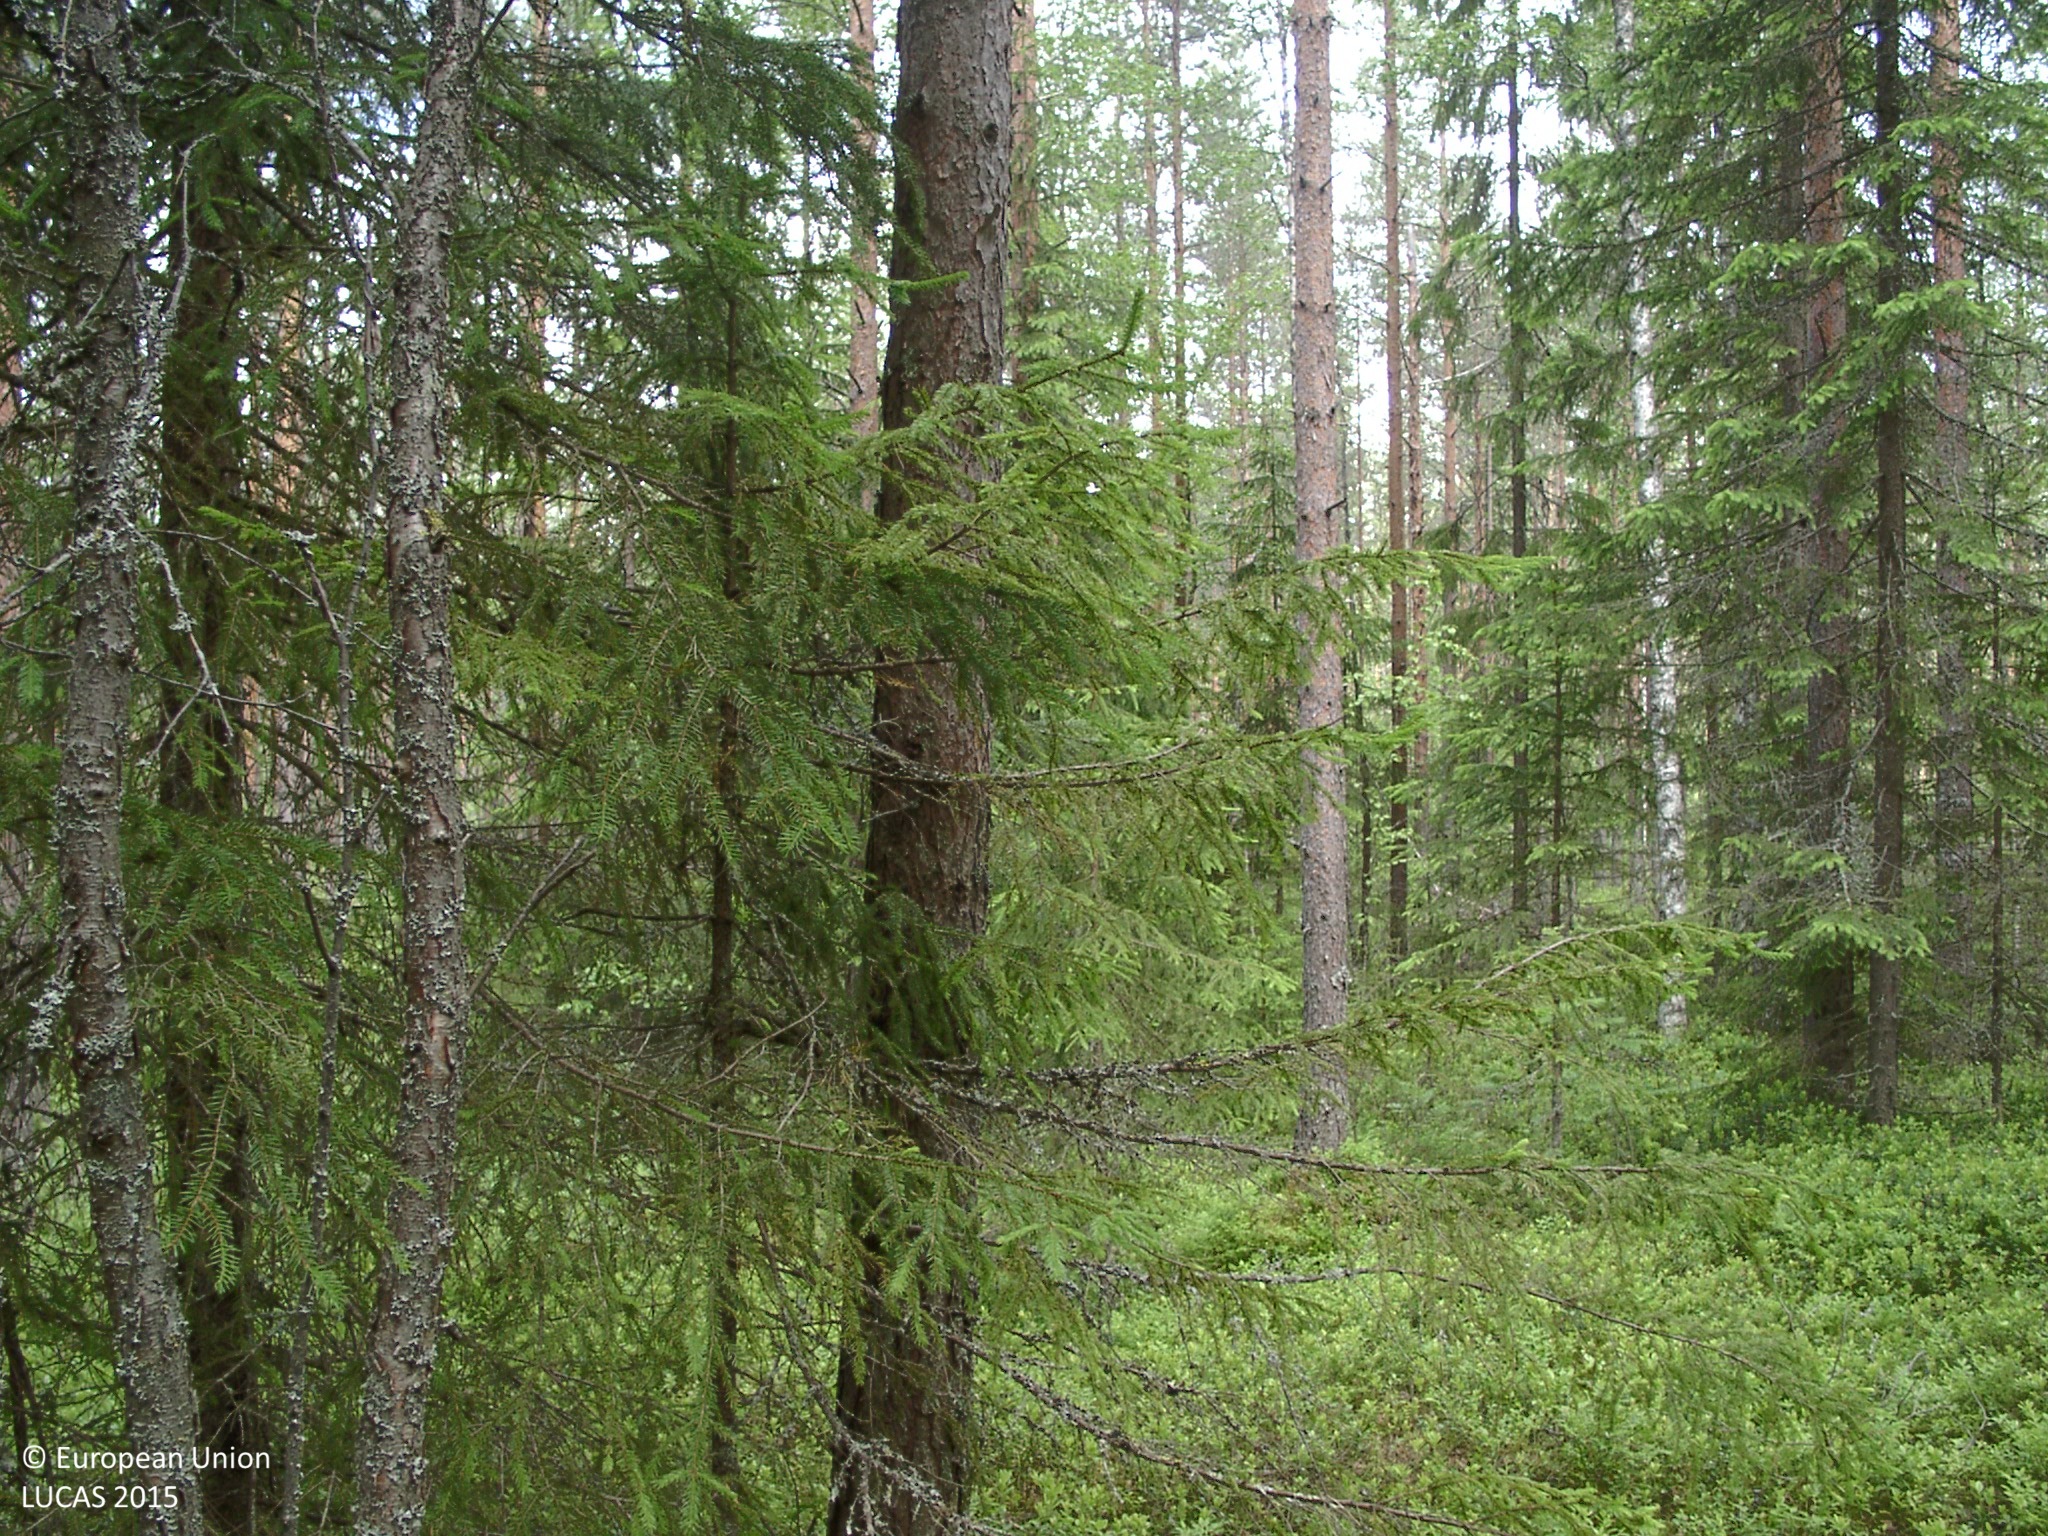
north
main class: Woodland
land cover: Other coniferous woodland
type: boreal forest
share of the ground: 50 - 75 %
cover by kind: coniferous forest trees 50 %, shrubs 35 %, broadleaved forest trees 10 %, lichens and mosses 5 %
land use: Semi-natural and natural areas not in use
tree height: > 5 m
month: June
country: FI
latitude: 62.0442
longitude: 24.7656
